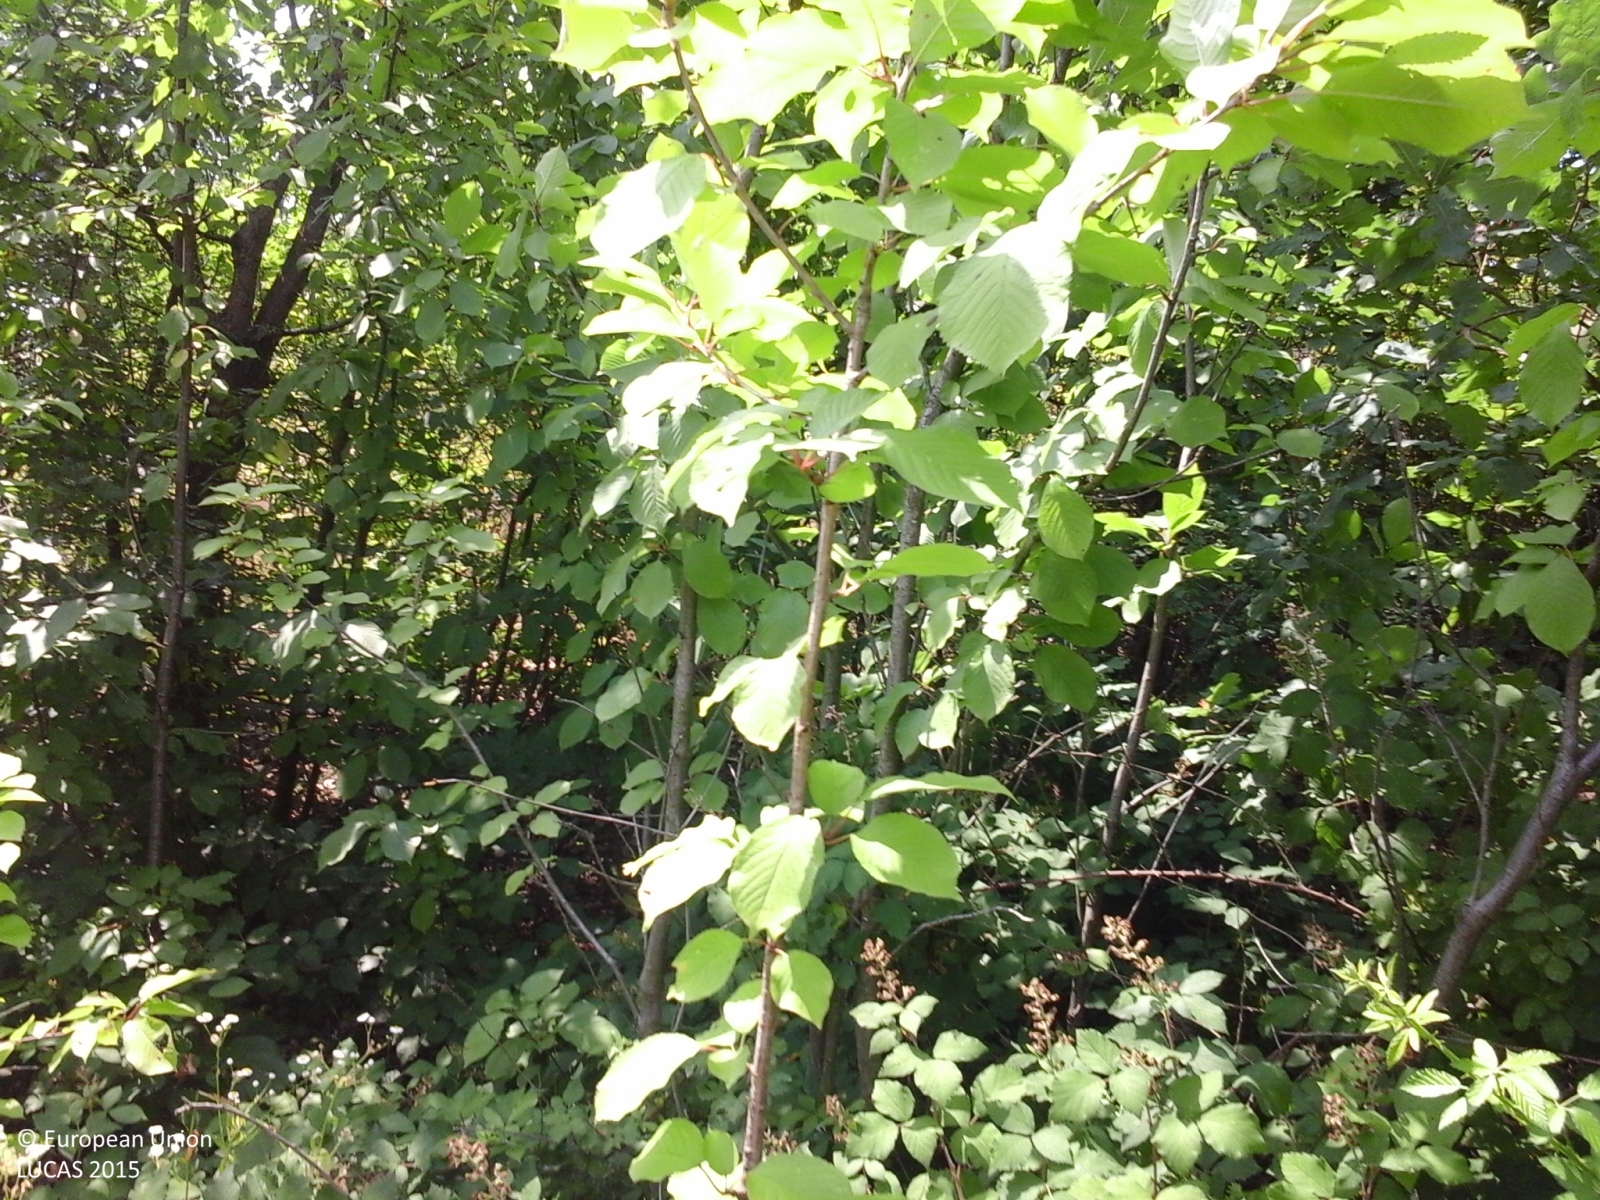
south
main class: Woodland
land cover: Broadleaved woodland
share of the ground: > 75 %
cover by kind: broadleaved forest trees 70 %, shrubs 20 %, herbaceous plants 10 %
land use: Semi-natural and natural areas not in use
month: July
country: IT
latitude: 44.7729
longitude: 8.5246
